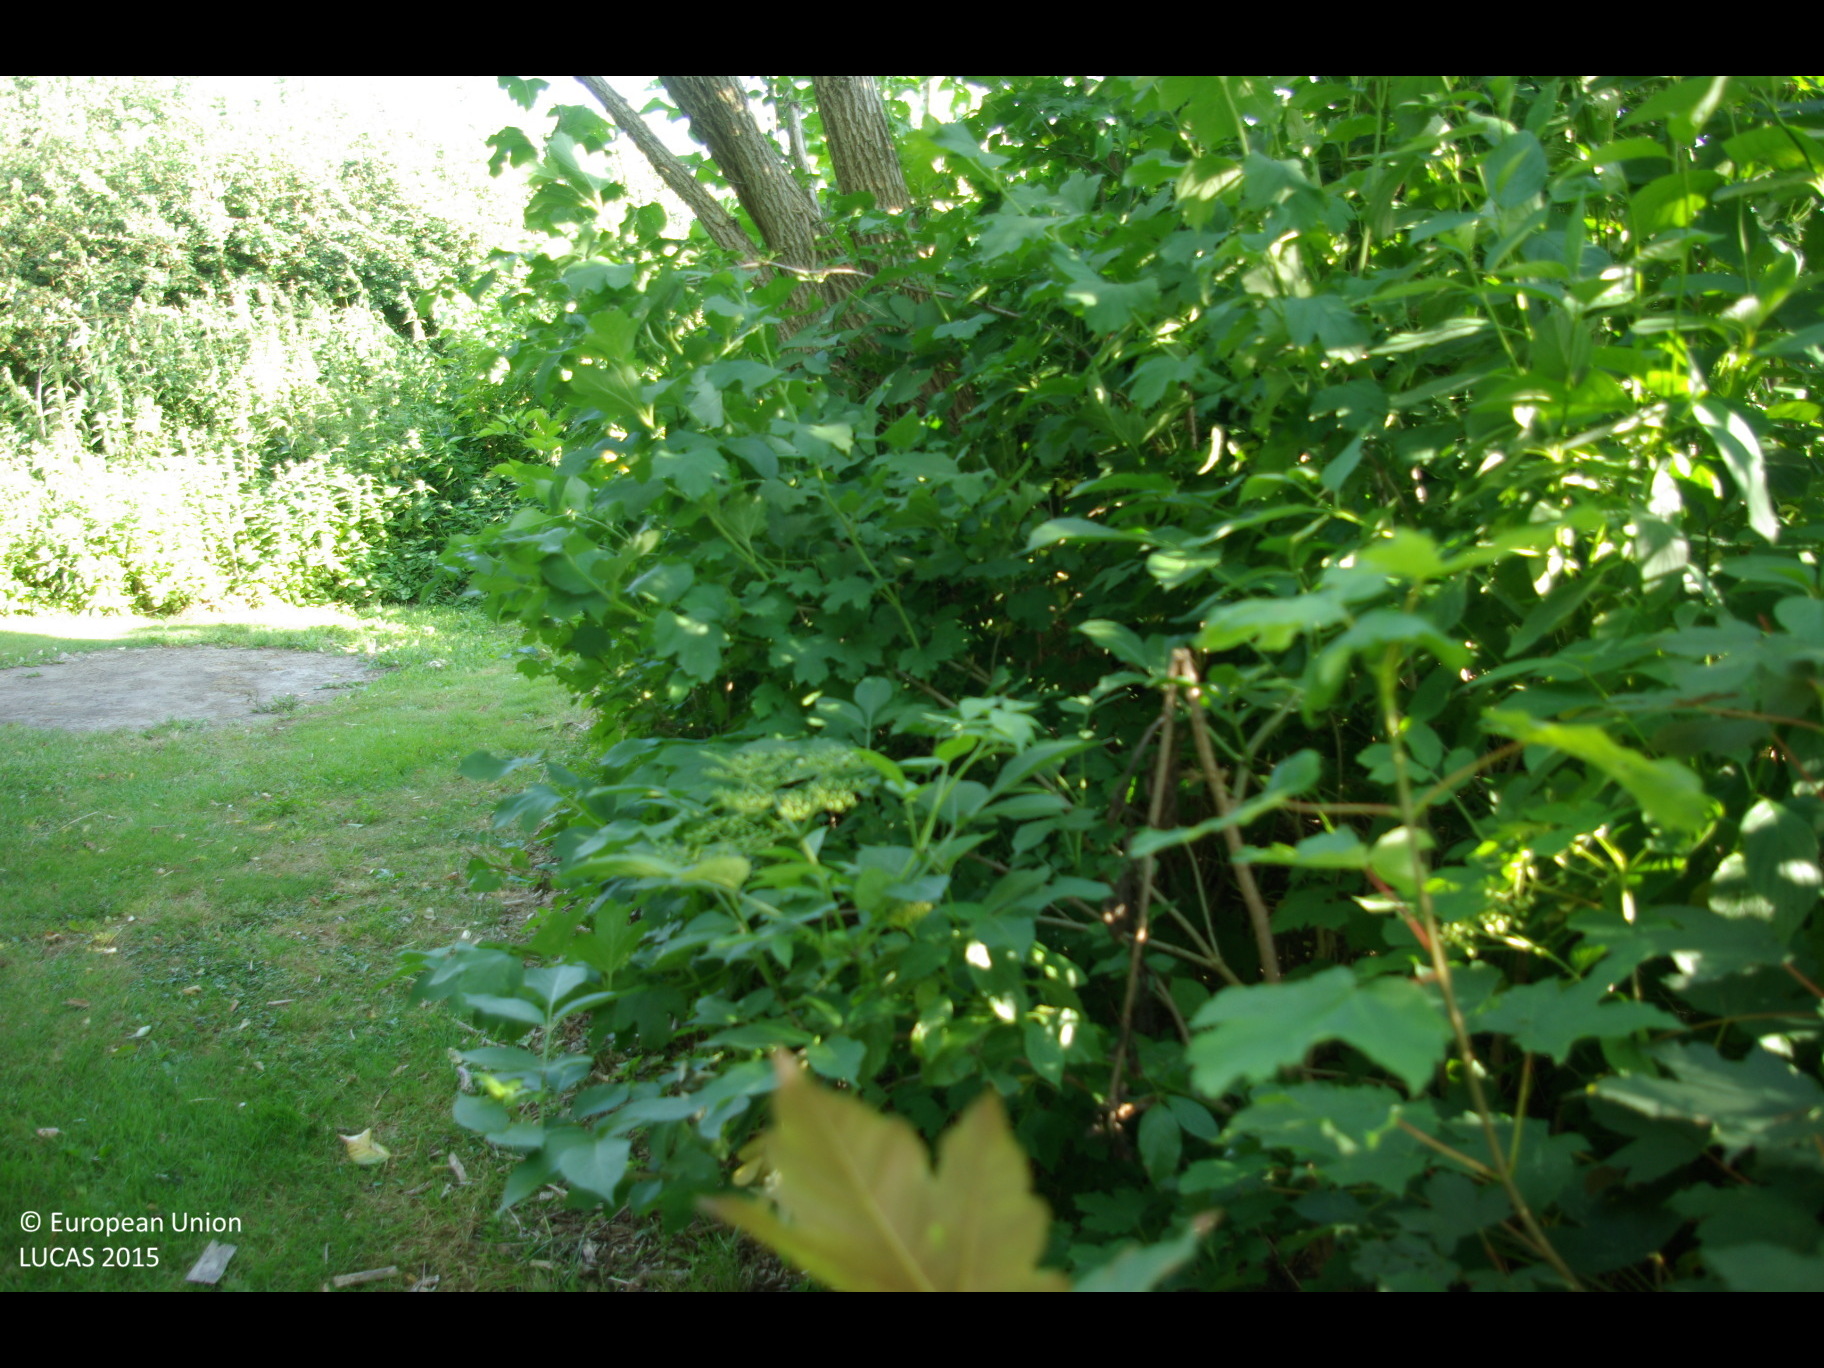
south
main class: Grassland
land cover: Grassland without tree/shrub cover
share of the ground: > 75 %
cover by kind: herbaceous plants 100 %
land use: Residential
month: July
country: DE
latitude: 54.7138
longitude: 9.8604
